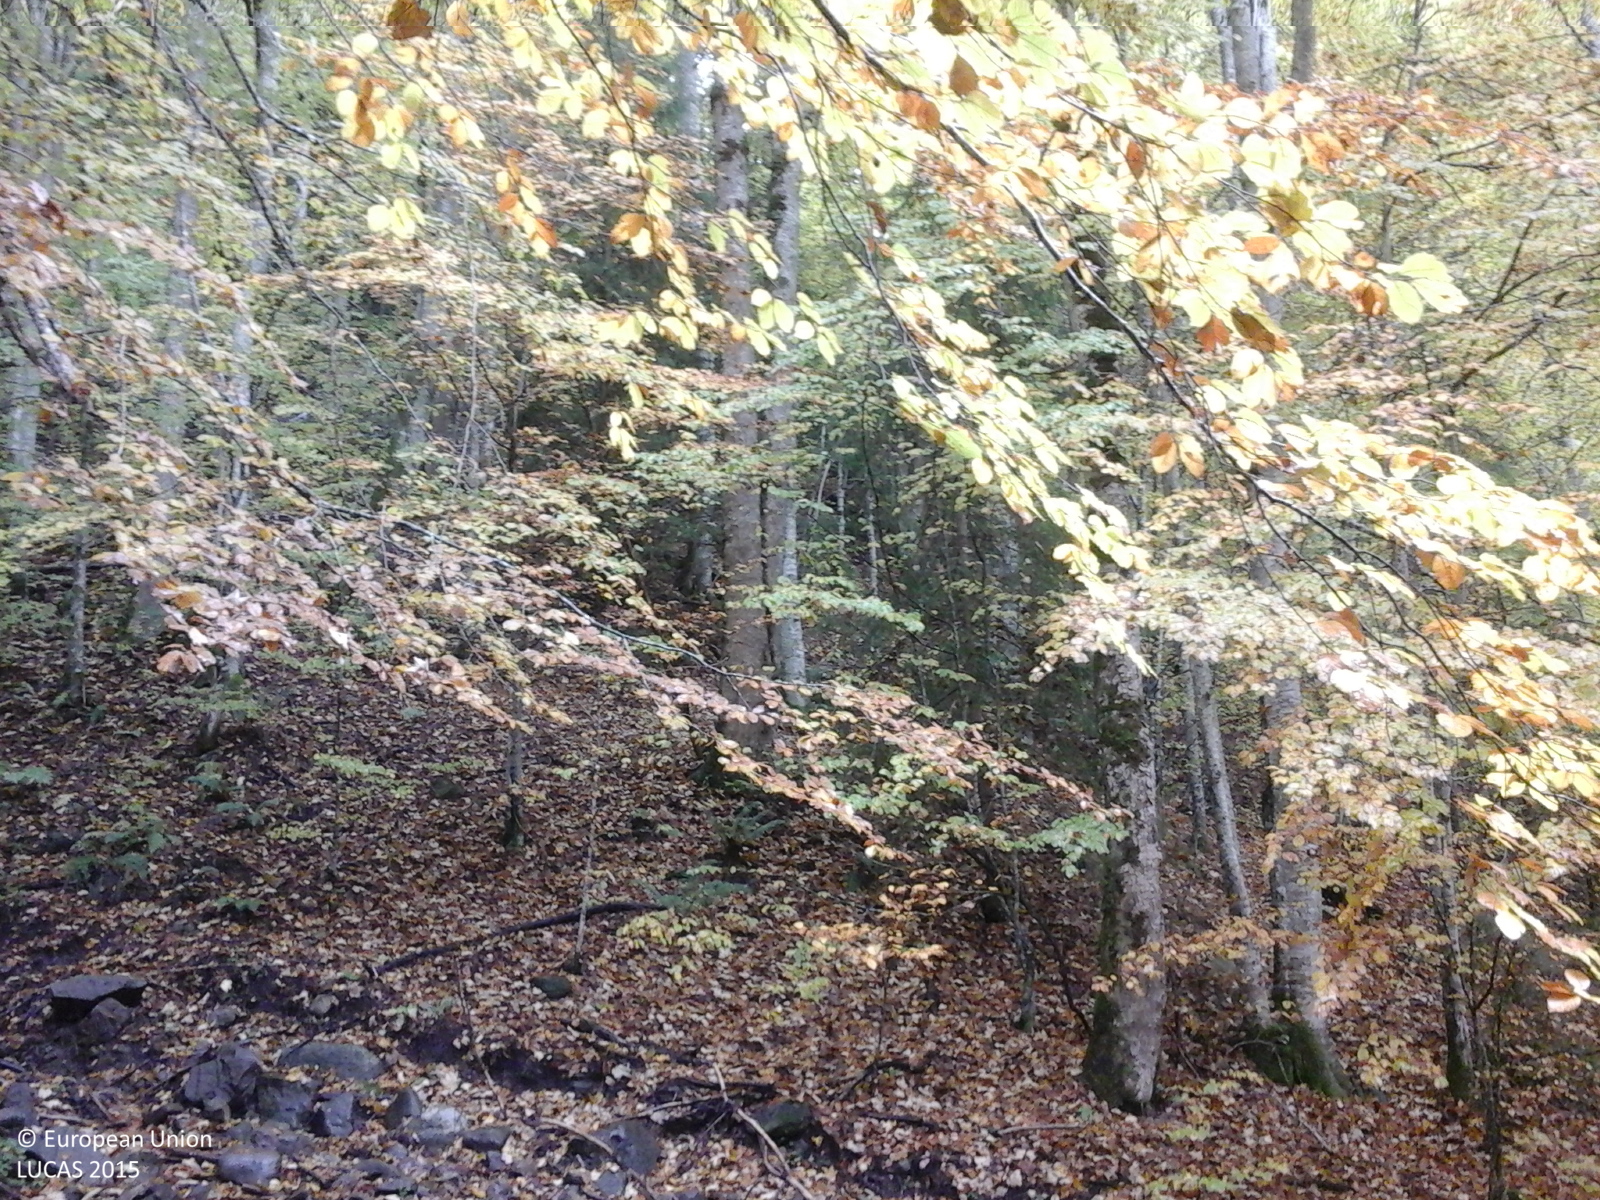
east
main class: Woodland
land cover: Broadleaved woodland
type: beech forest
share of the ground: > 75 %
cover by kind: broadleaved forest trees 100 %
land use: Forestry
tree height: > 5 m
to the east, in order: Broadleaved woodland
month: October
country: RO
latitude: 46.7764
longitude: 25.2045
